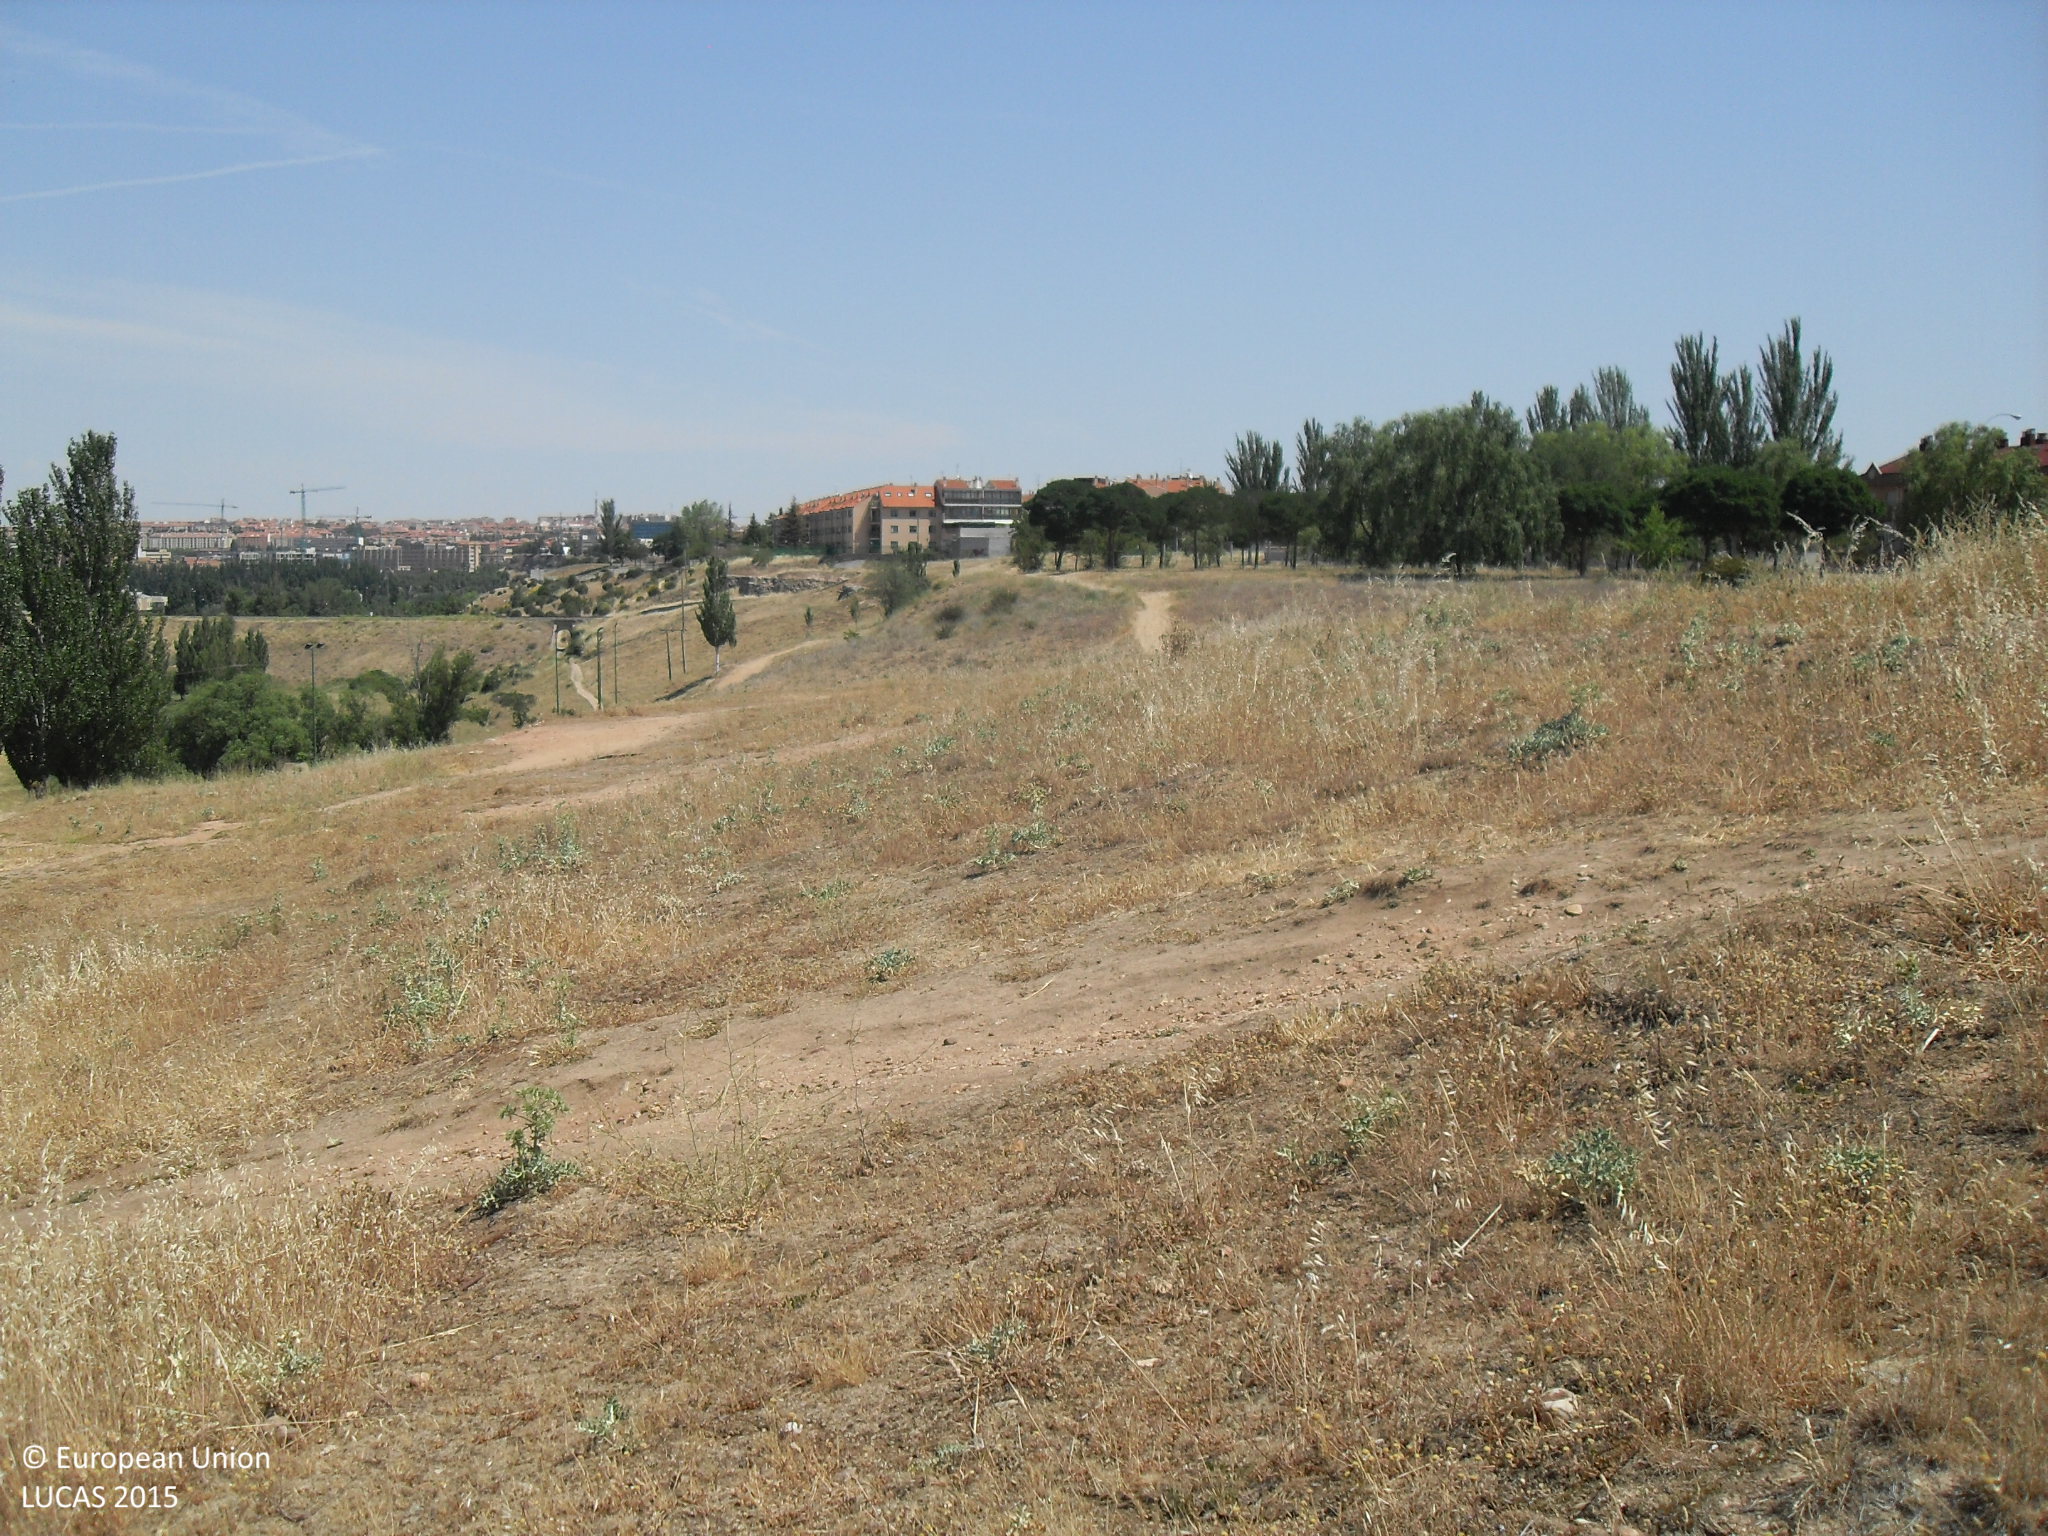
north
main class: Grassland
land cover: Grassland with sparse tree/shrub cover
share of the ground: > 75 %
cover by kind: herbaceous plants 95 %, coniferous forest trees 5 %
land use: Semi-natural and natural areas not in use
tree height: > 5 m
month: June
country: ES
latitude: 40.9473
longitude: -5.6743
